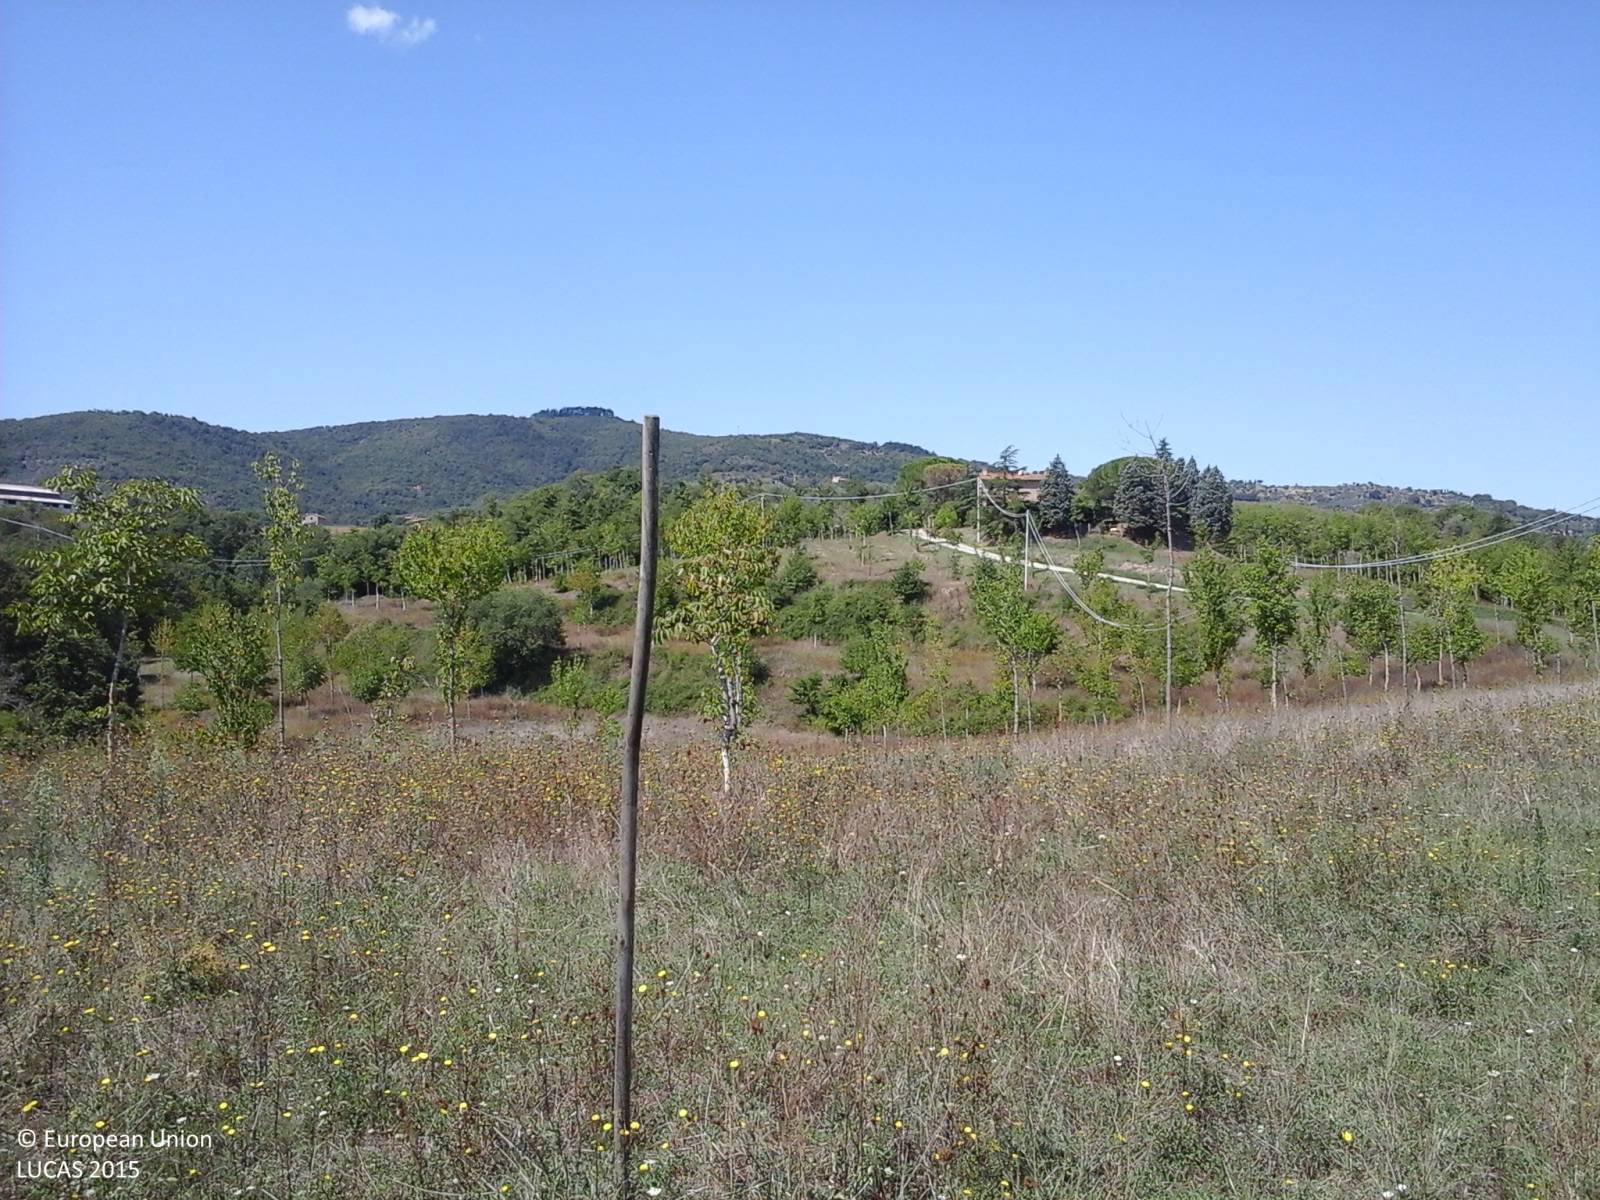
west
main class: Cropland
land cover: Nuts trees
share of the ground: 10 - 25 %
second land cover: Grassland without tree/shrub cover
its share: > 75 %
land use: Agriculture (excluding fallow land and kitchen gardens)
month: September
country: IT
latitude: 43.0113
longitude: 12.1162
